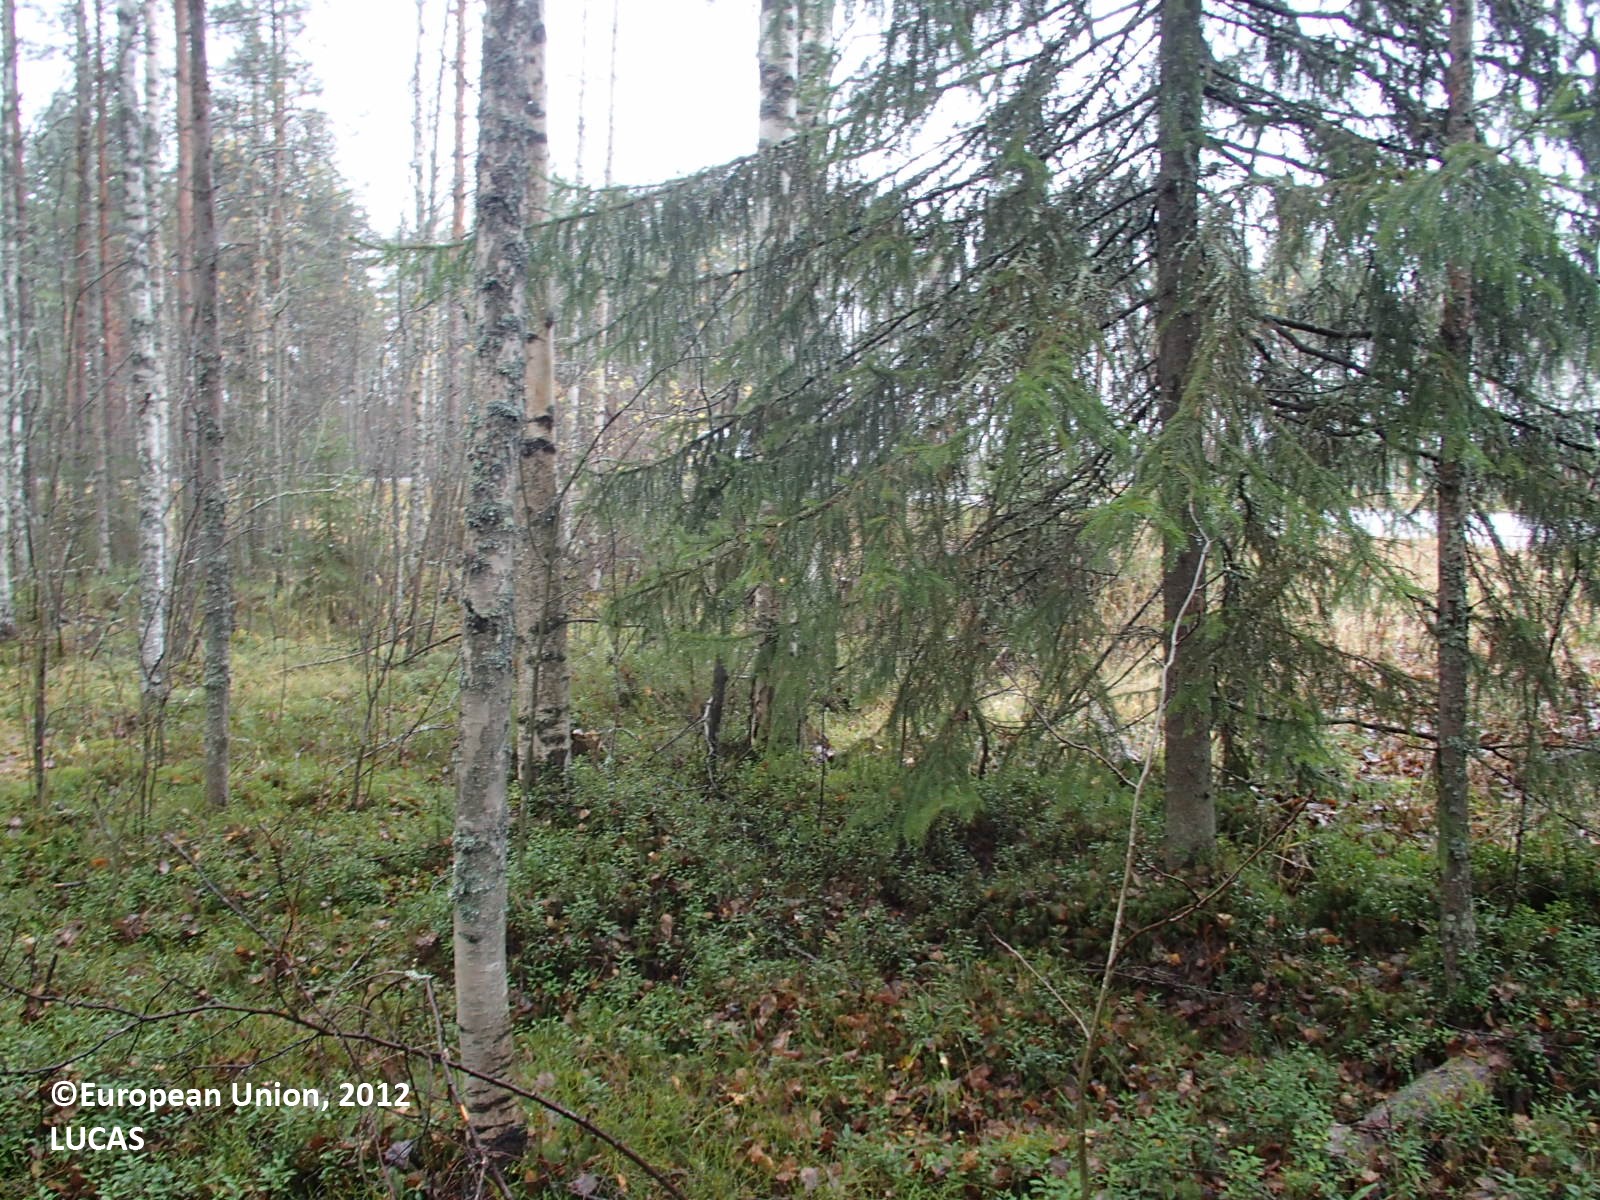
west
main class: Woodland
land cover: Pine dominated mixed woodland
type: boreal forest
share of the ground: > 75 %
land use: Forestry
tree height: > 5 m
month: October
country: FI
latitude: 63.8597
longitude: 26.8340
